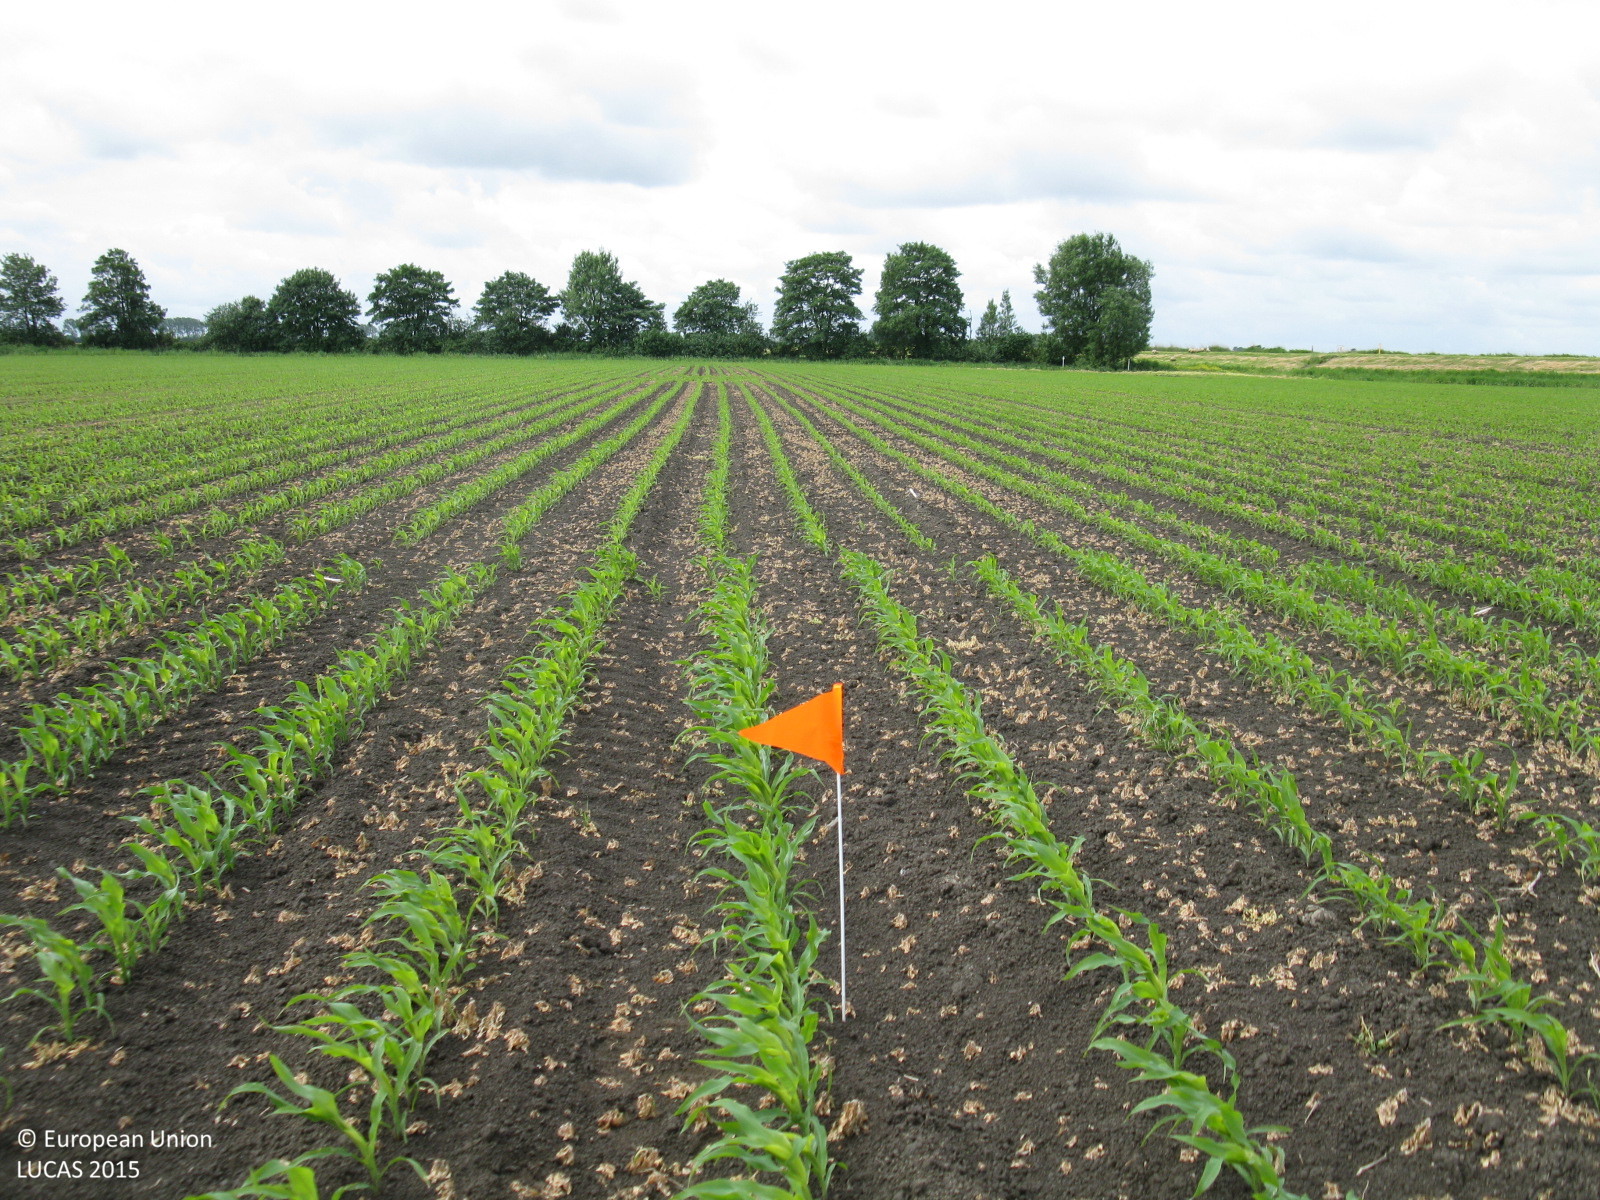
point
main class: Cropland
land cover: Maize
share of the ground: 10 - 25 %
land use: Agriculture (excluding fallow land and kitchen gardens)
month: June
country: DE
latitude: 53.4087
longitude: 7.3380
